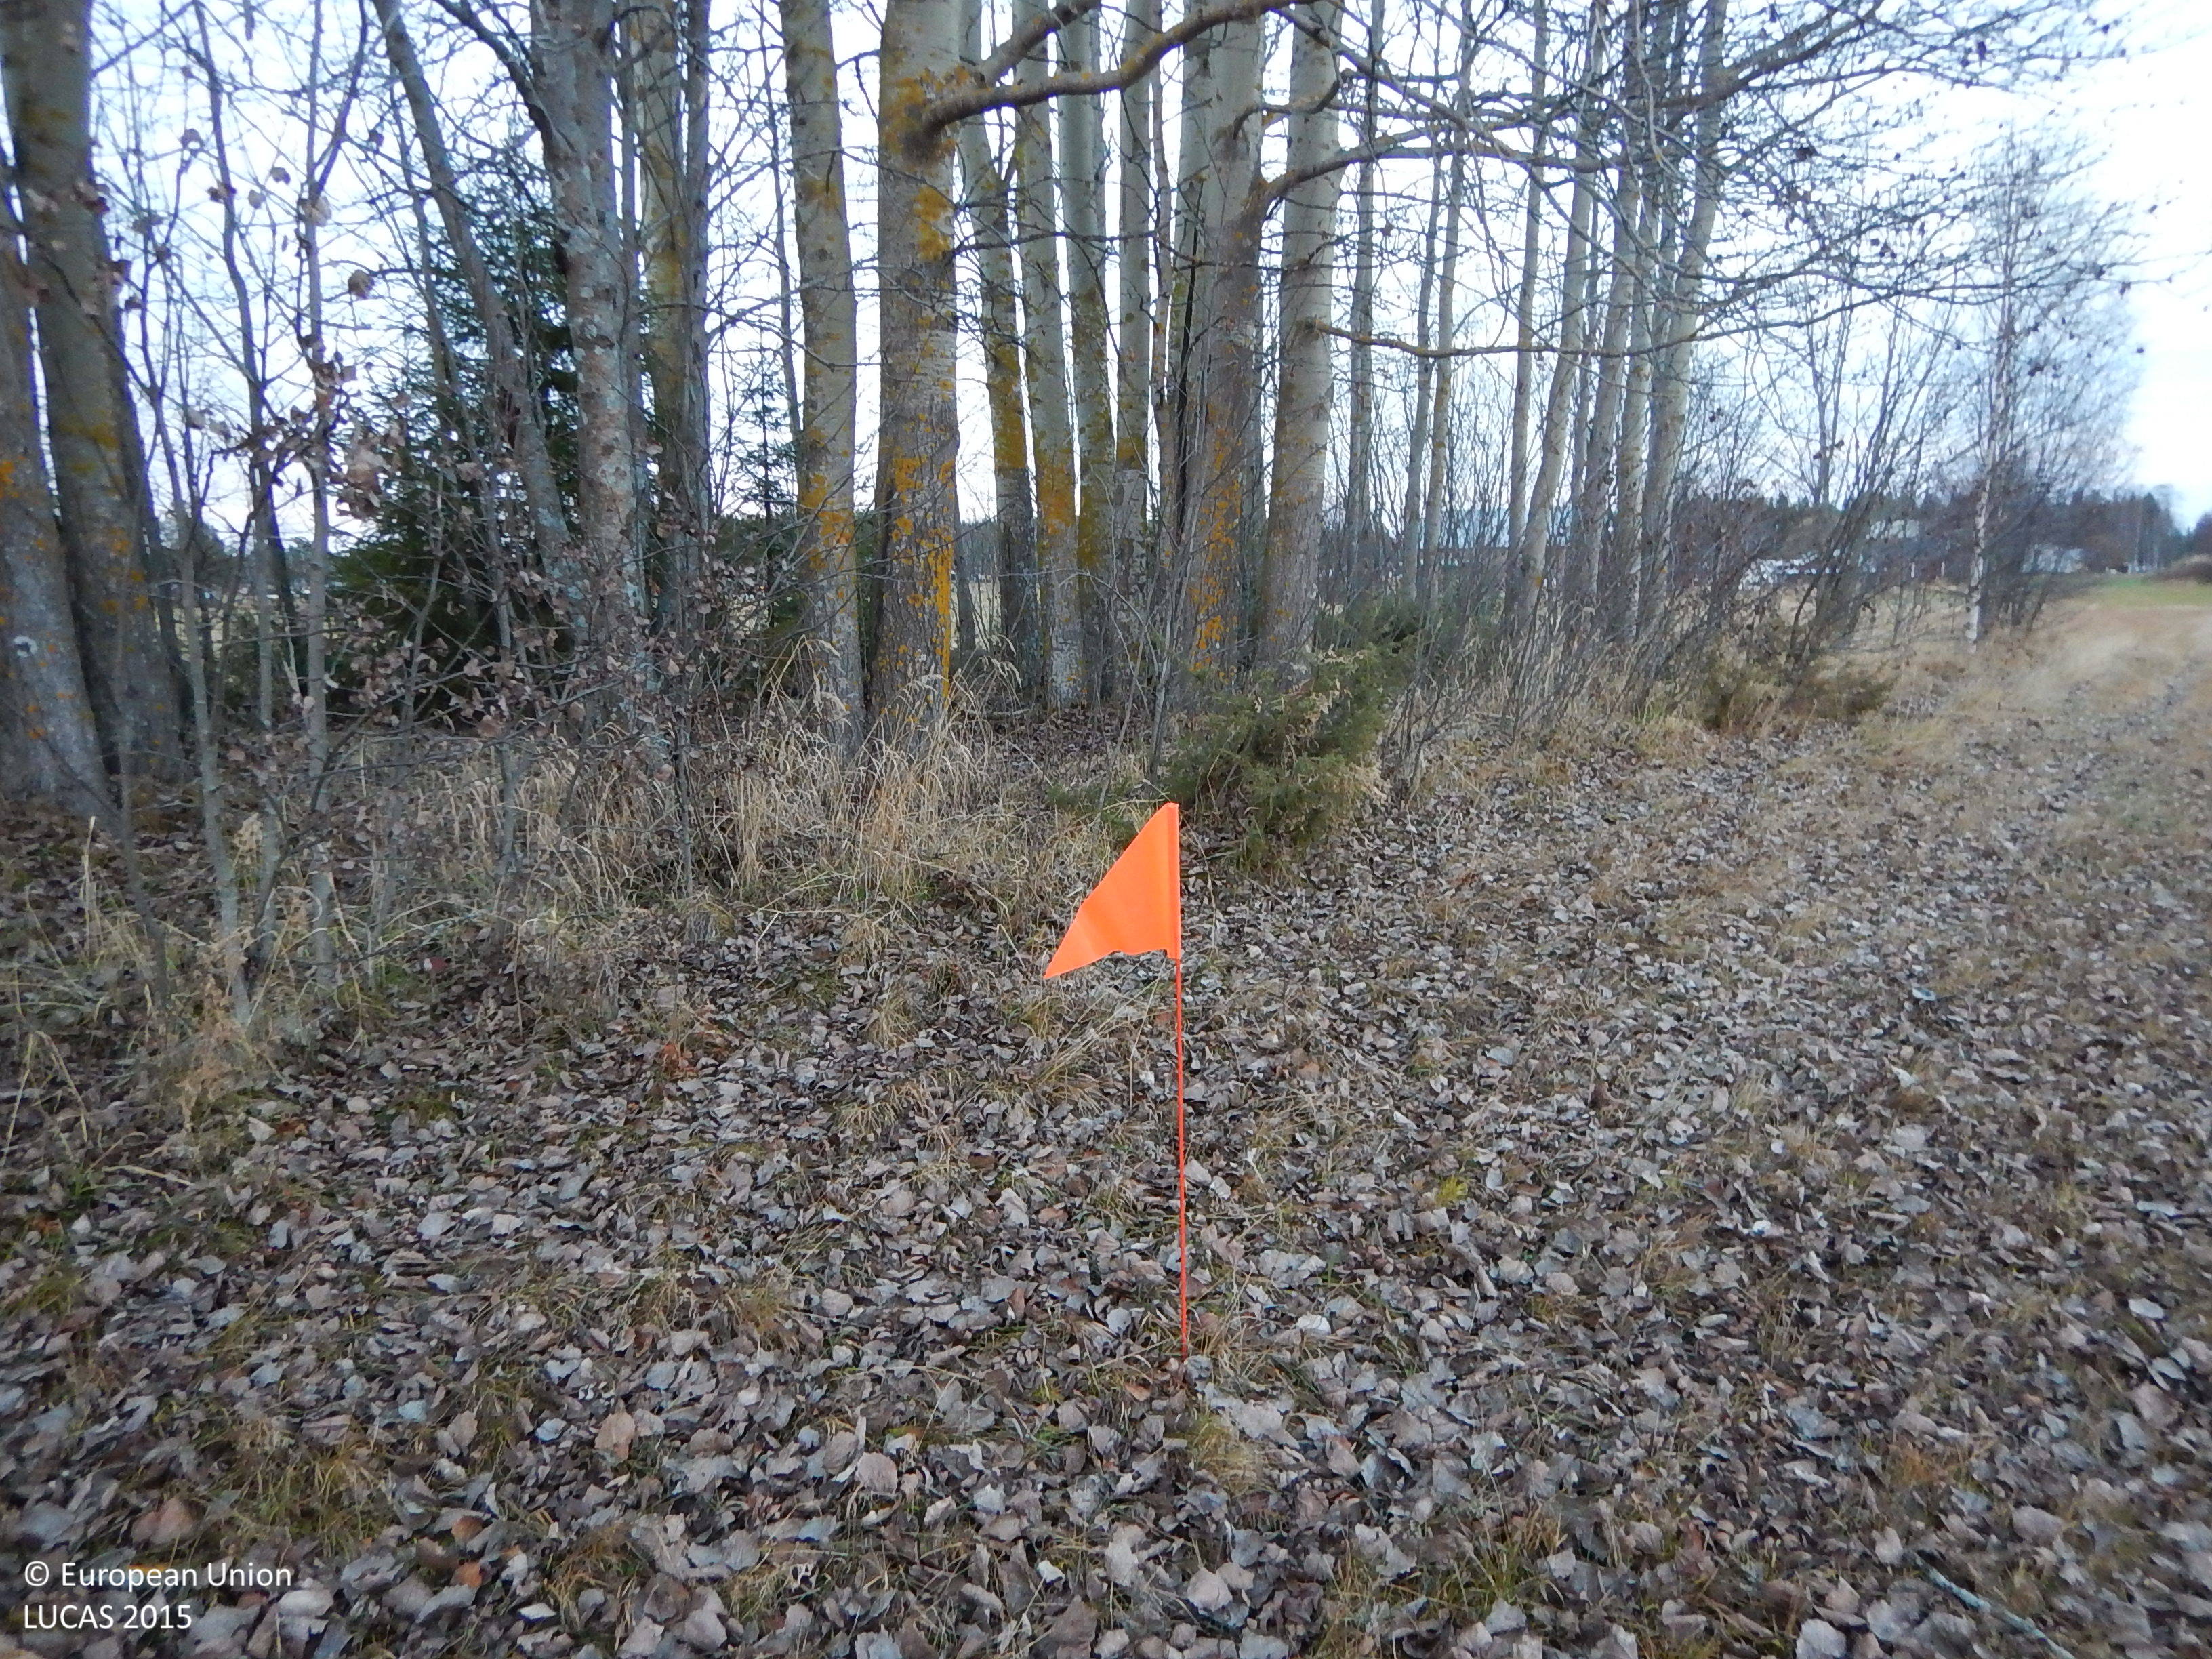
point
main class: Grassland
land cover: Grassland without tree/shrub cover
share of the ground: > 75 %
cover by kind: herbaceous plants 100 %
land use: Agriculture (excluding fallow land and kitchen gardens)
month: October
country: SE
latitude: 65.3678
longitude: 21.2627
